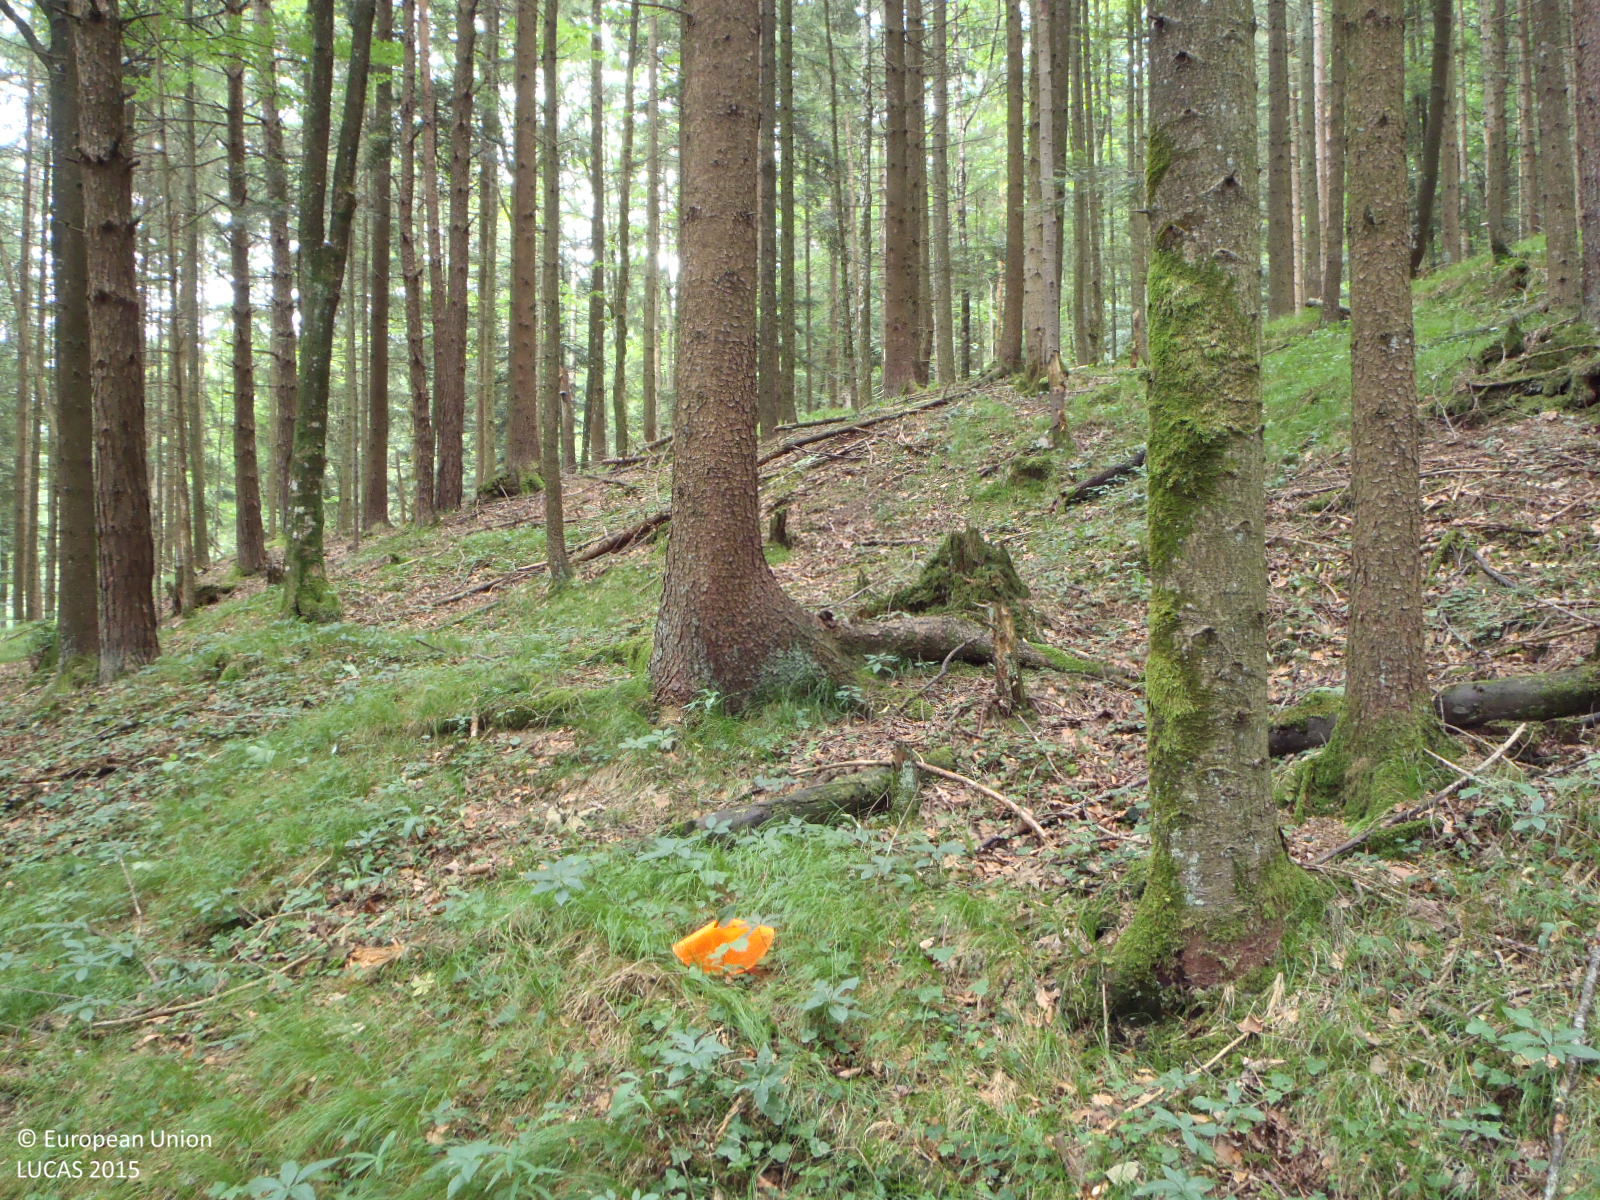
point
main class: Woodland
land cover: Spruce dominated coniferous woodland
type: alpine coniferous forest
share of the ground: > 75 %
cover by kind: coniferous forest trees 80 %, broadleaved forest trees 10 %, herbaceous plants 10 %
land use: Forestry
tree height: > 5 m
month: July
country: AT
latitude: 47.5896
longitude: 12.1926
